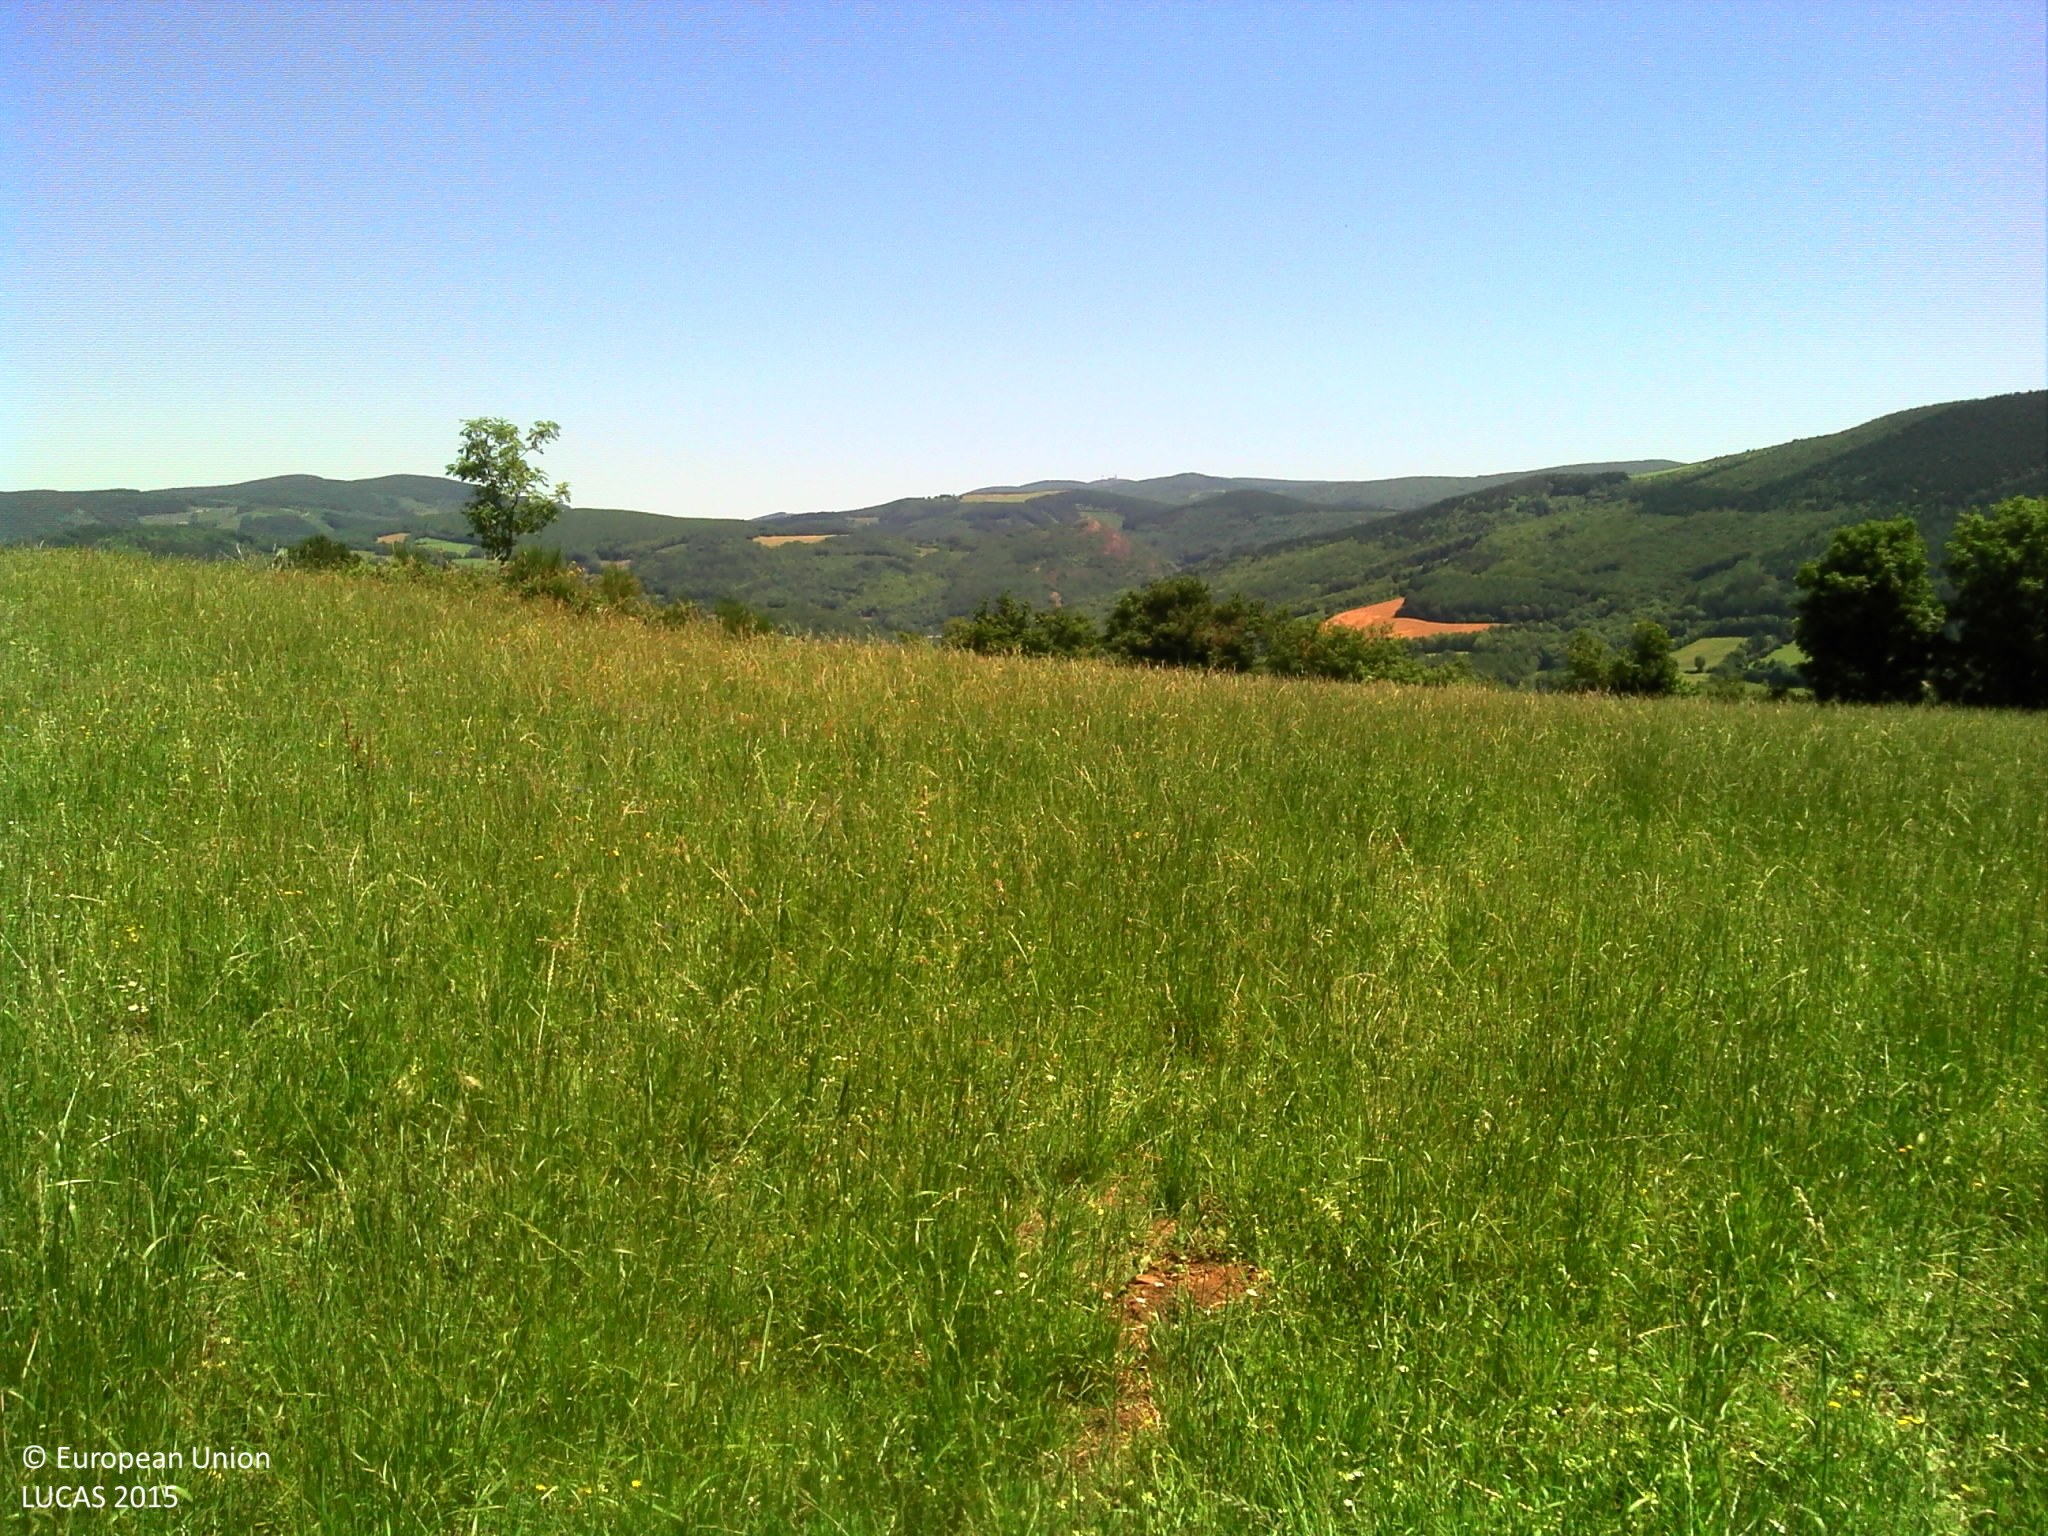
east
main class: Grassland
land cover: Grassland without tree/shrub cover
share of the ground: > 75 %
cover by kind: herbaceous plants 100 %
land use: Agriculture (excluding fallow land and kitchen gardens)
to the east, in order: Grassland without tree/shrub cover; Single bushes/trees; Grassland without tree/shrub cover; Shrubland without tree cover; Tracks; Grassland without tree/shrub cover; Shrubland with sparse tree cover
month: June
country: FR
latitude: 43.7219
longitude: 2.5708
